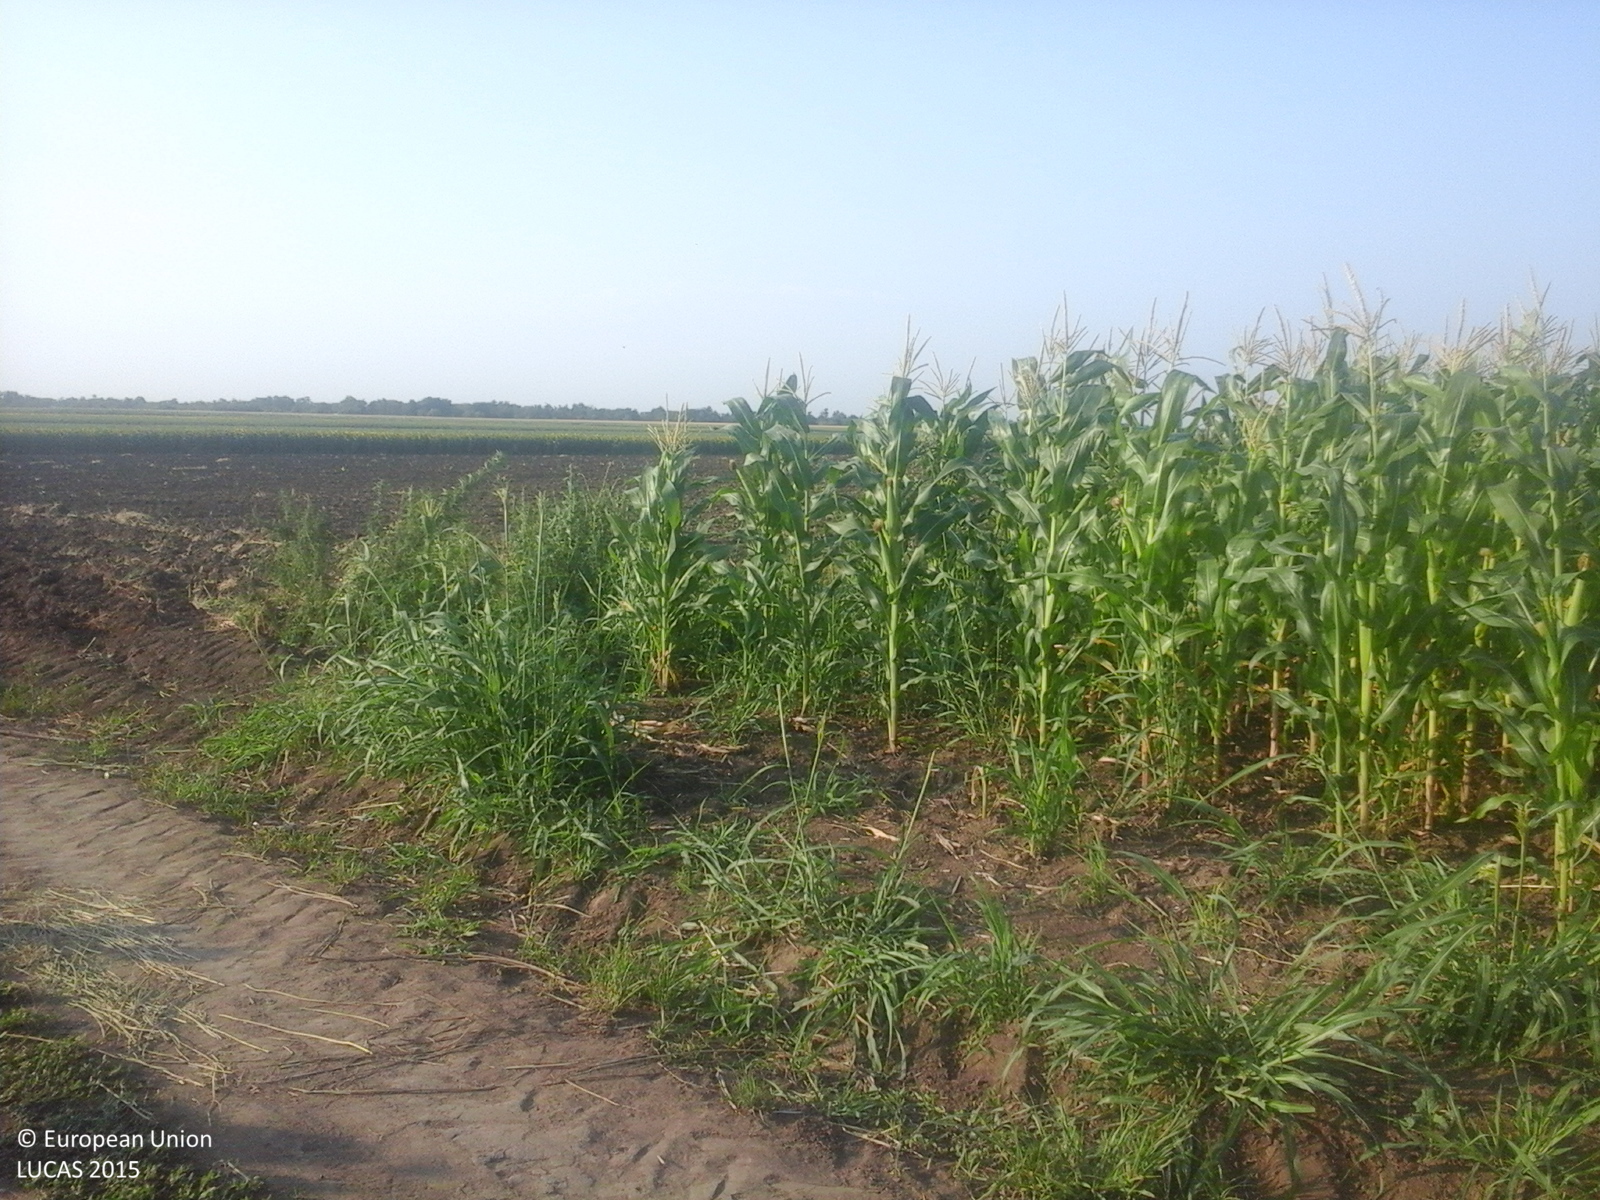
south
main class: Cropland
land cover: Sunflower
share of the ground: > 75 %
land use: Agriculture (excluding fallow land and kitchen gardens)
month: July
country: RO
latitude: 44.8221
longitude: 27.3806
